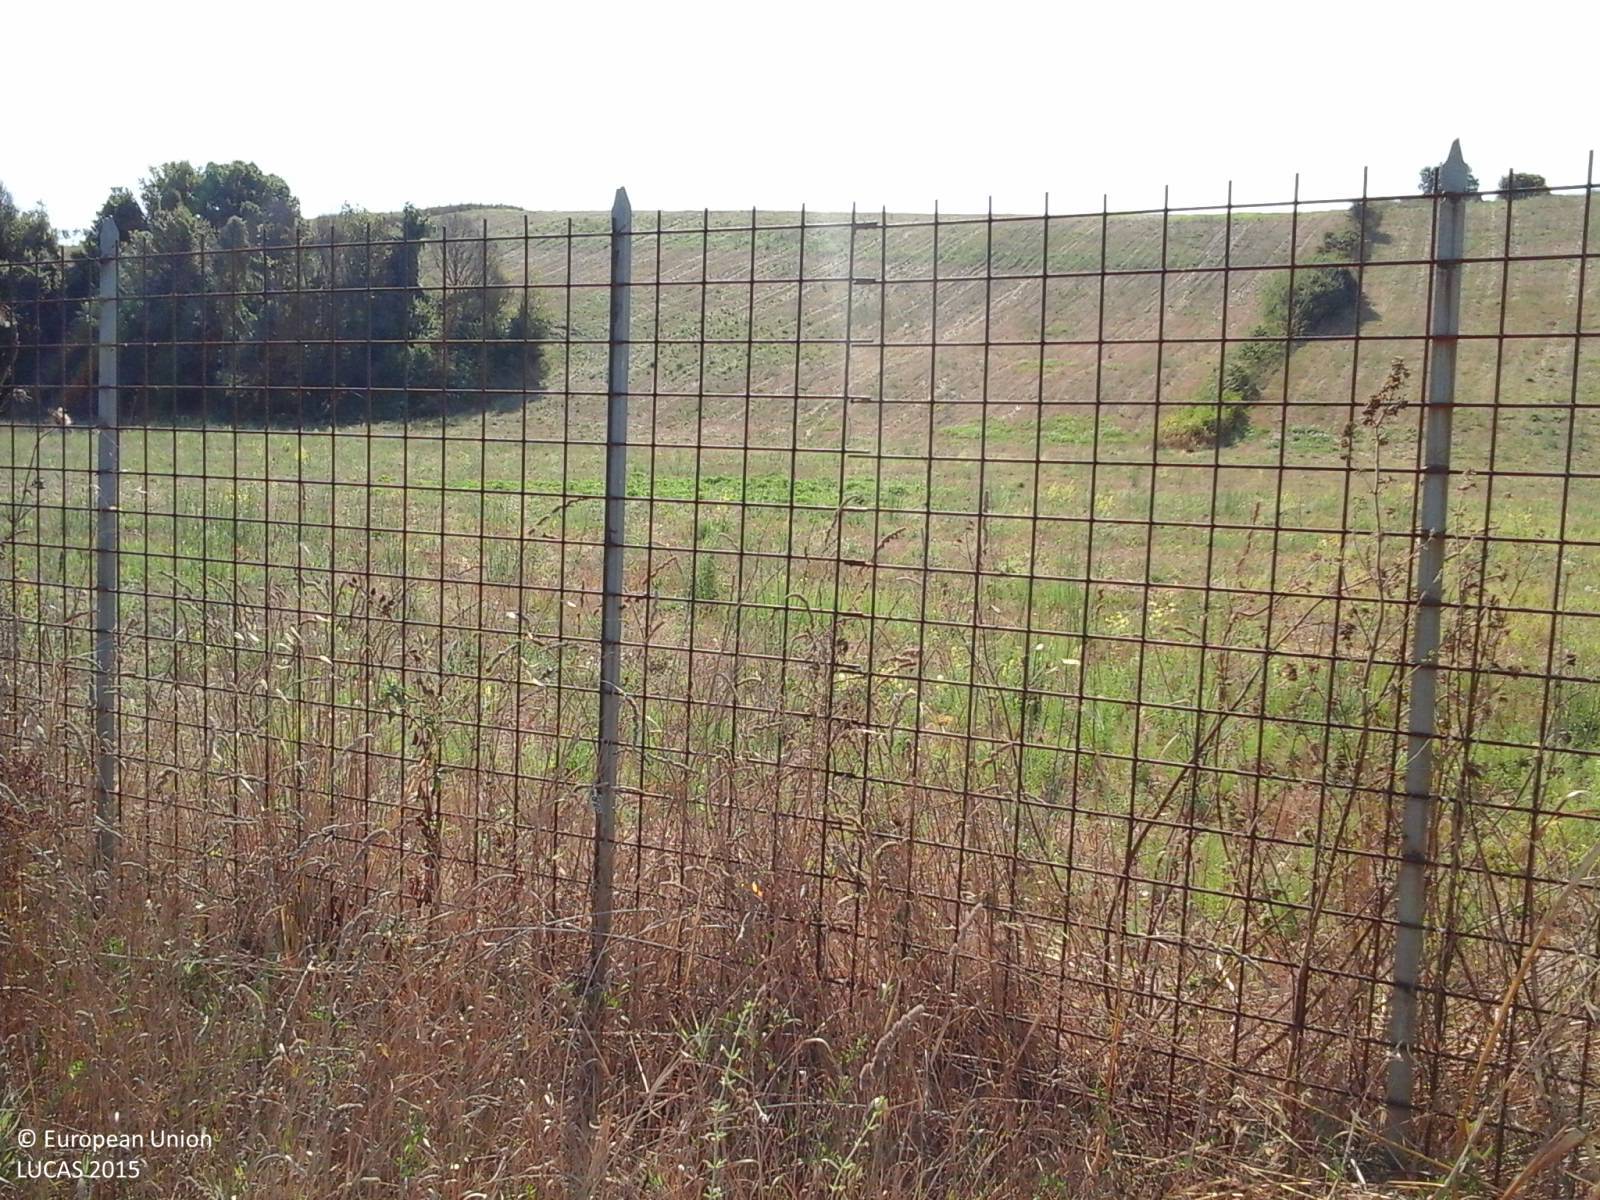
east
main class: Cropland
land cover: Mixed cereals for fodder
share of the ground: > 75 %
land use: Agriculture (excluding fallow land and kitchen gardens)
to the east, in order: Mixed cereals for fodder; Abandoned hedges; Mixed cereals for fodder; Artificial constructions in urban areas; Shrubland with sparse tree cover
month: August
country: IT
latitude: 42.0852
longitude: 12.3247
